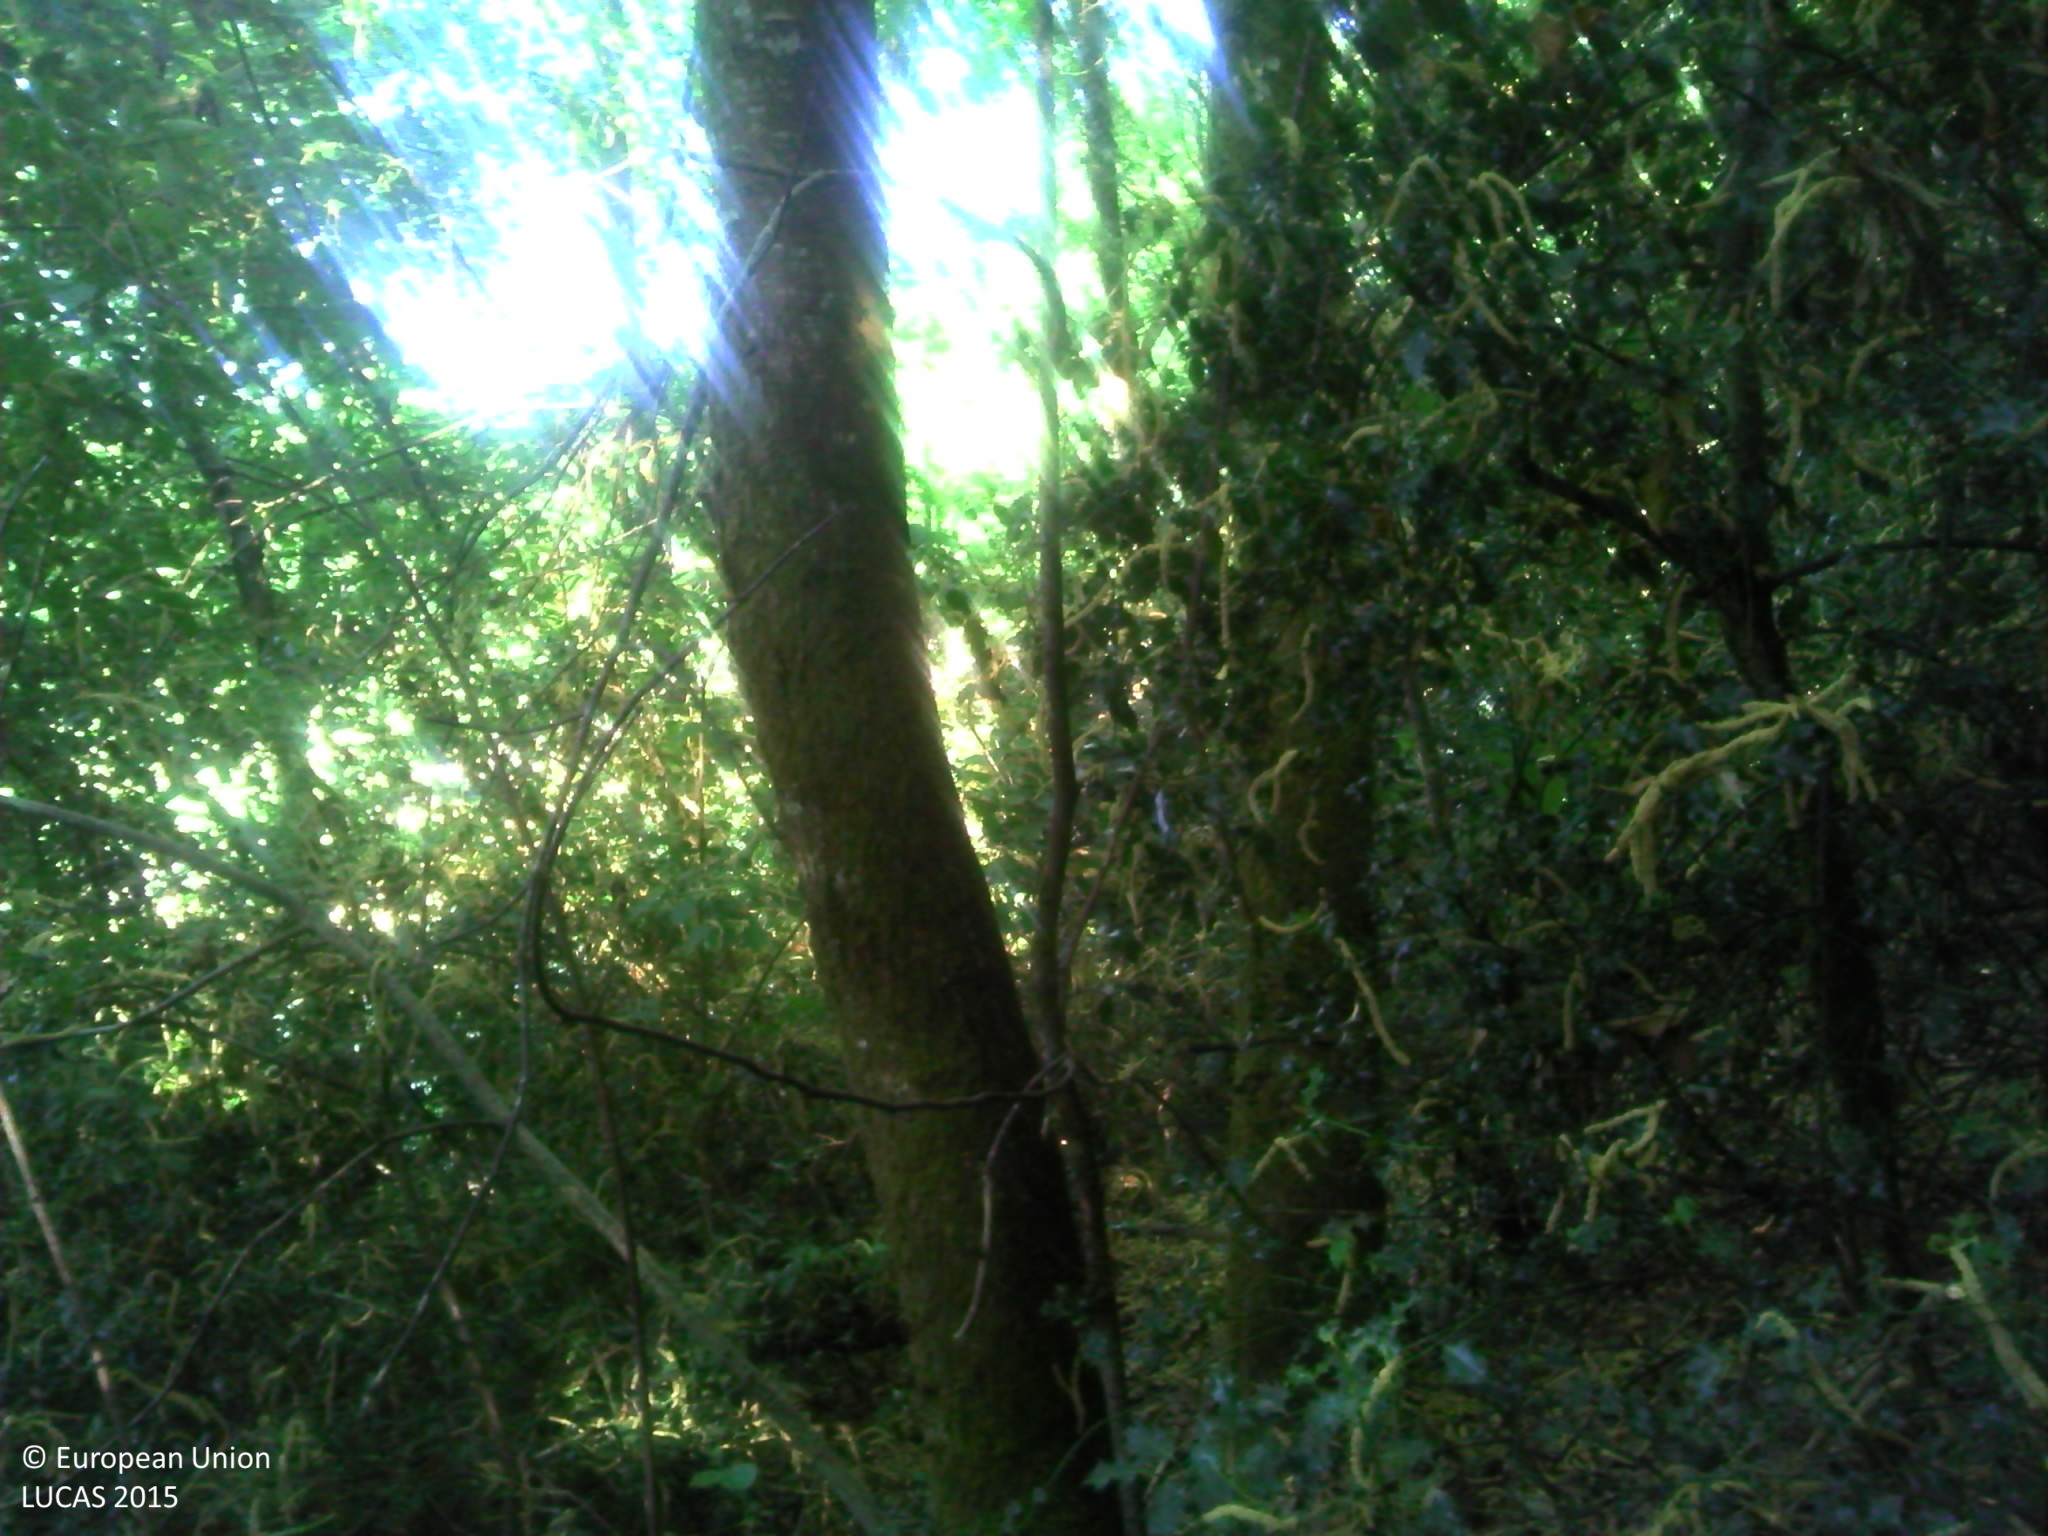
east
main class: Woodland
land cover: Broadleaved woodland
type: mesophytic deciduous forest
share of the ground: > 75 %
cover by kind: broadleaved forest trees 100 %
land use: Forestry
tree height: > 5 m
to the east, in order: Broadleaved woodland; Fences; Grassland without tree/shrub cover; Fences; Broadleaved woodland; Fences; Broadleaved woodland; Rivers and streams; Broadleaved woodland; Ditches and canals; Grass margins; Paved roads, cycling and walking lanes; Grass margins; Shruby margins; Broadleaved woodland
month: July
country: FR
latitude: 46.2694
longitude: 1.5438
